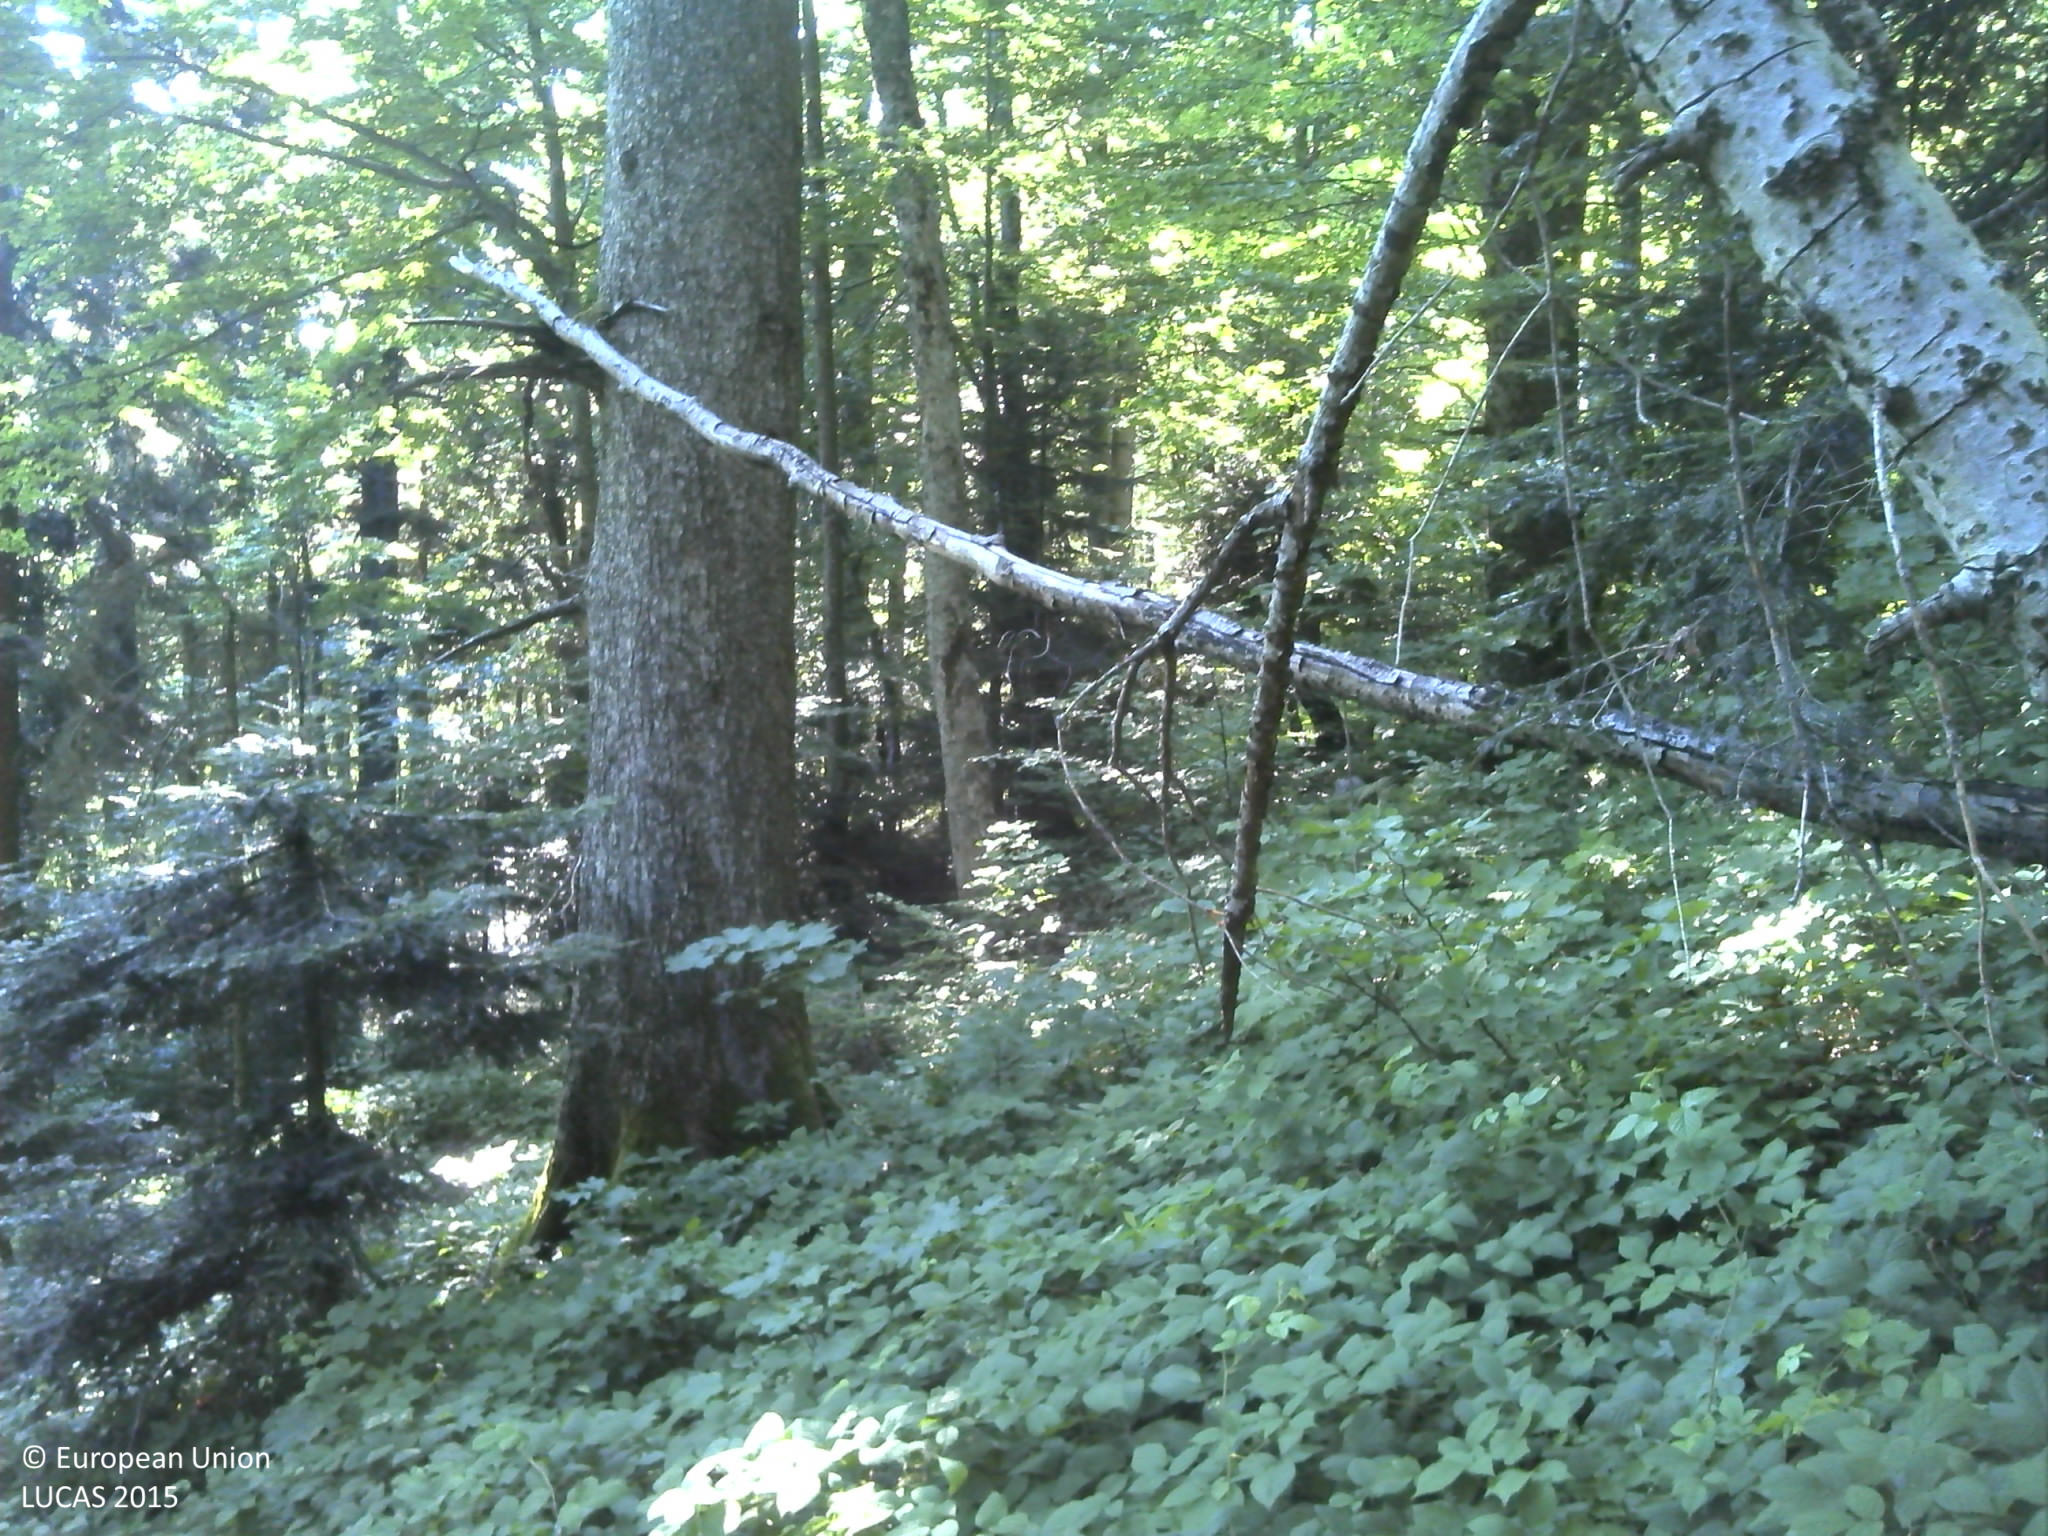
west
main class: Woodland
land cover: Broadleaved woodland
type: mountainous beech forest
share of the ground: > 75 %
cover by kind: broadleaved forest trees 90 %, shrubs 10 %
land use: Forestry
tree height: > 5 m
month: July
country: HR
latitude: 45.0865
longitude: 15.2165
